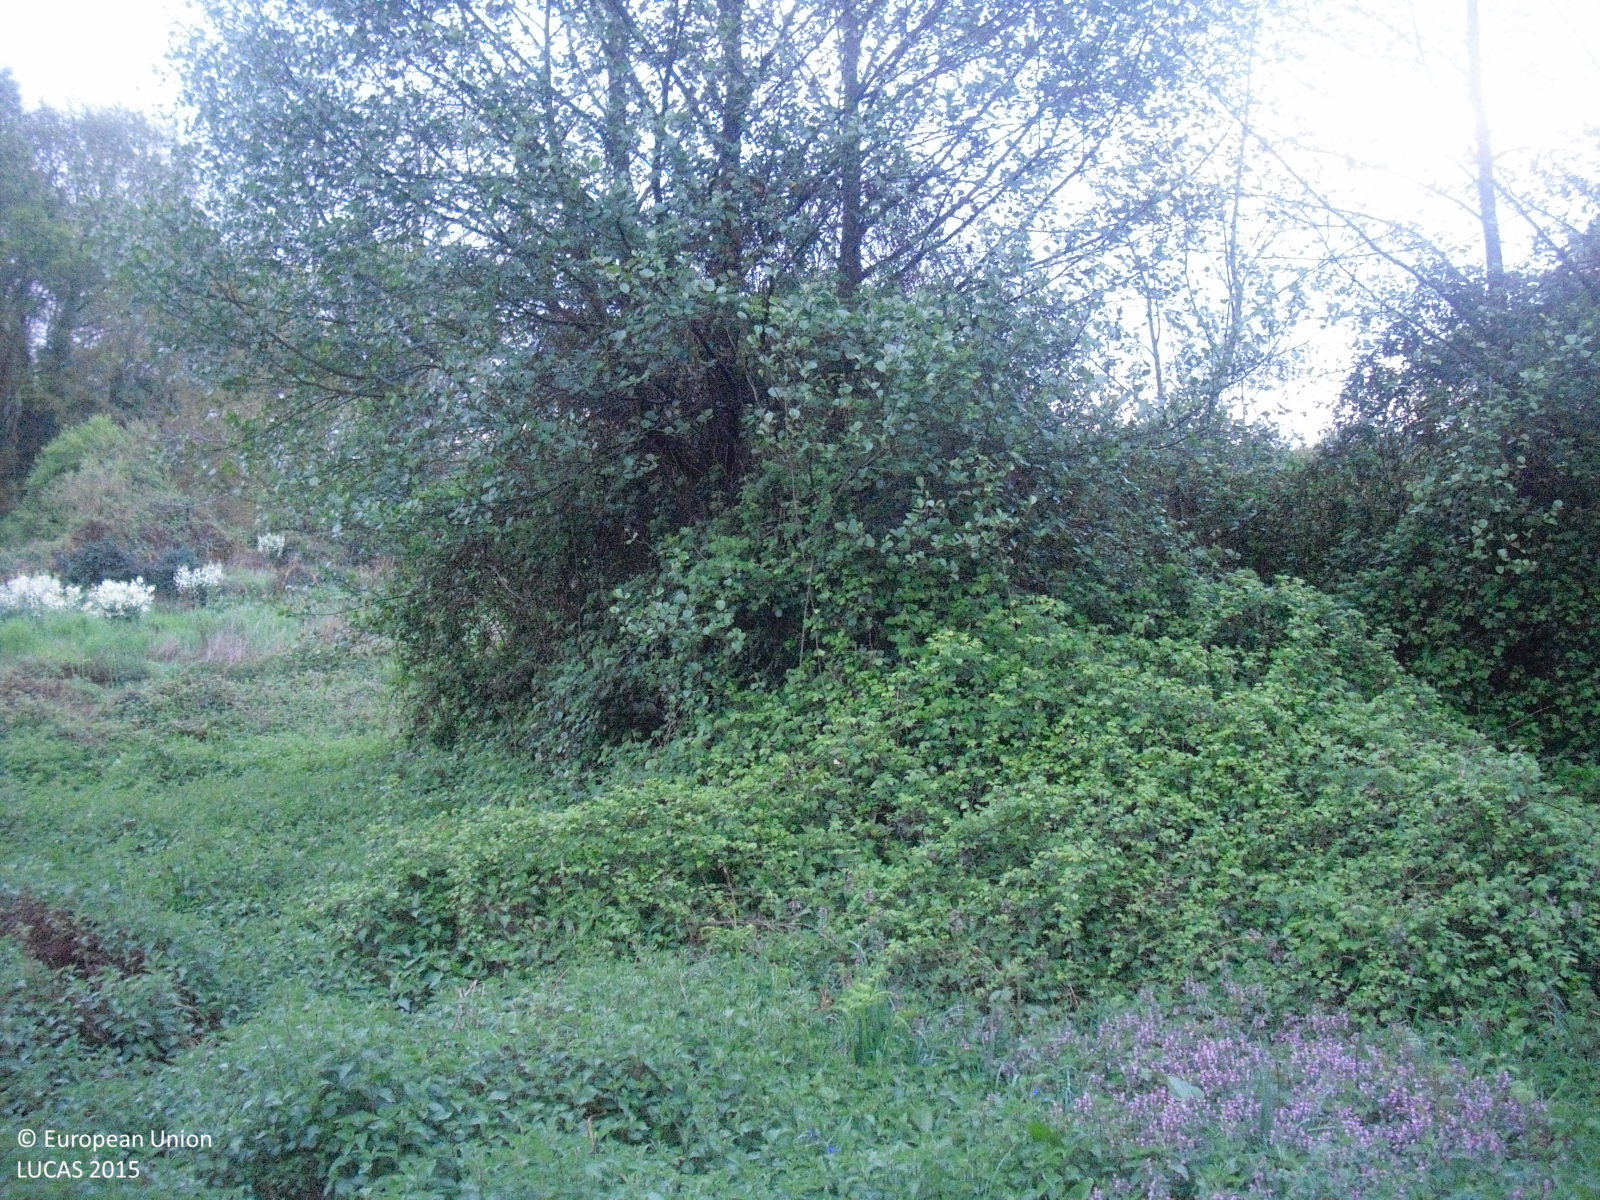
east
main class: Grassland
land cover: Grassland with sparse tree/shrub cover
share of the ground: > 75 %
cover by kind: herbaceous plants 85 %, shrubs 10 %, broadleaved forest trees 5 %
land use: Semi-natural and natural areas not in use
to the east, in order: Grassland with sparse tree/shrub cover; Shrubland without tree cover; Single bushes/trees; Spontaneously vegetated surfaces; Dry stone walls; Tracks; Abandoned hedges; Dry stone walls; Ditches and canals; Grassland without tree/shrub cover; Electric lines; Grassland without tree/shrub cover; Shruby margins; Ditches and canals; Shruby margins; Tracks; Grassland with sparse tree/shrub cover; Paved roads, cycling and walking lanes; Grass margins; Shruby margins; Electric lines; Shrubland without tree cover; Tracks; Broadleaved woodland; Tracks; Abandoned hedges; Dry stone walls; Grassland with sparse tree/shrub cover; Shruby margins; Dry stone walls; Ditches and canals; Grassland without tree/shrub cover; Broadleaved woodland
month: April
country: ES
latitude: 42.1071
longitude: -7.8379
